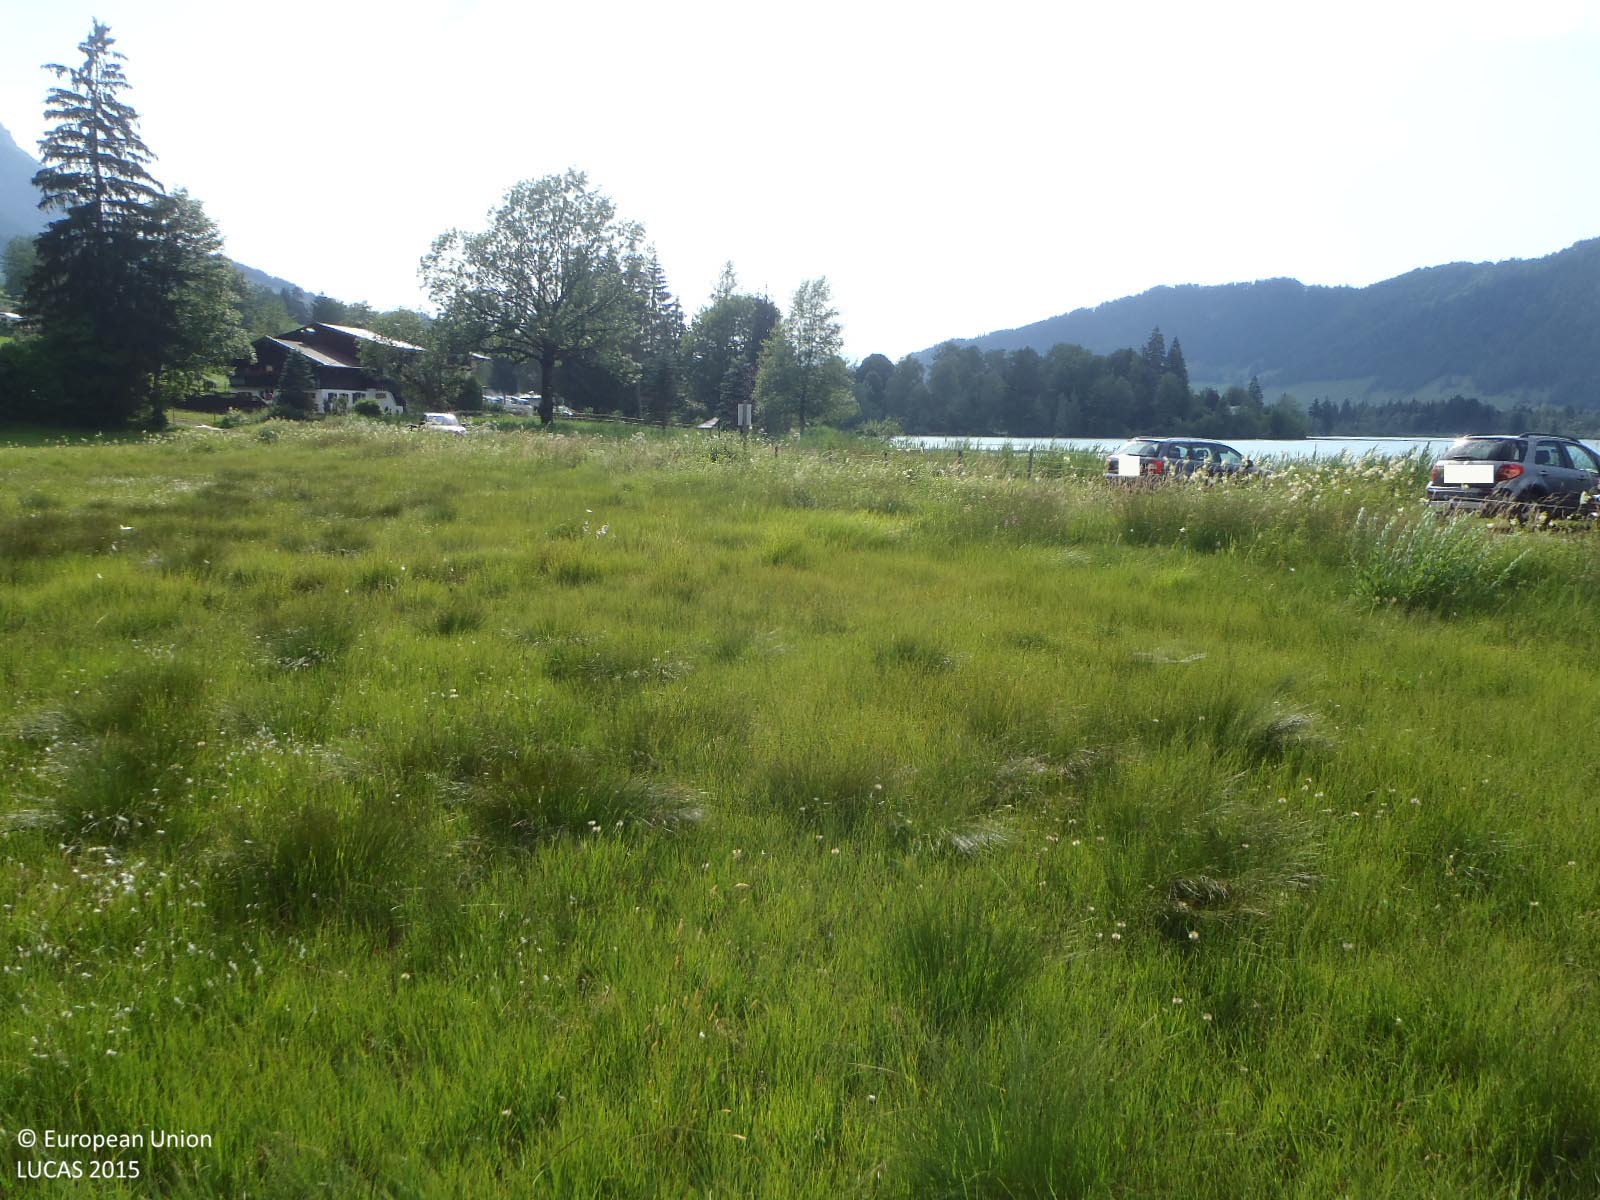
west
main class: Grassland
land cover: Grassland without tree/shrub cover
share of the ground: > 75 %
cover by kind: herbaceous plants 70 %, lichens and mosses 30 %
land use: Agriculture (excluding fallow land and kitchen gardens)
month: July
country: AT
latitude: 47.6408
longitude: 12.3279
